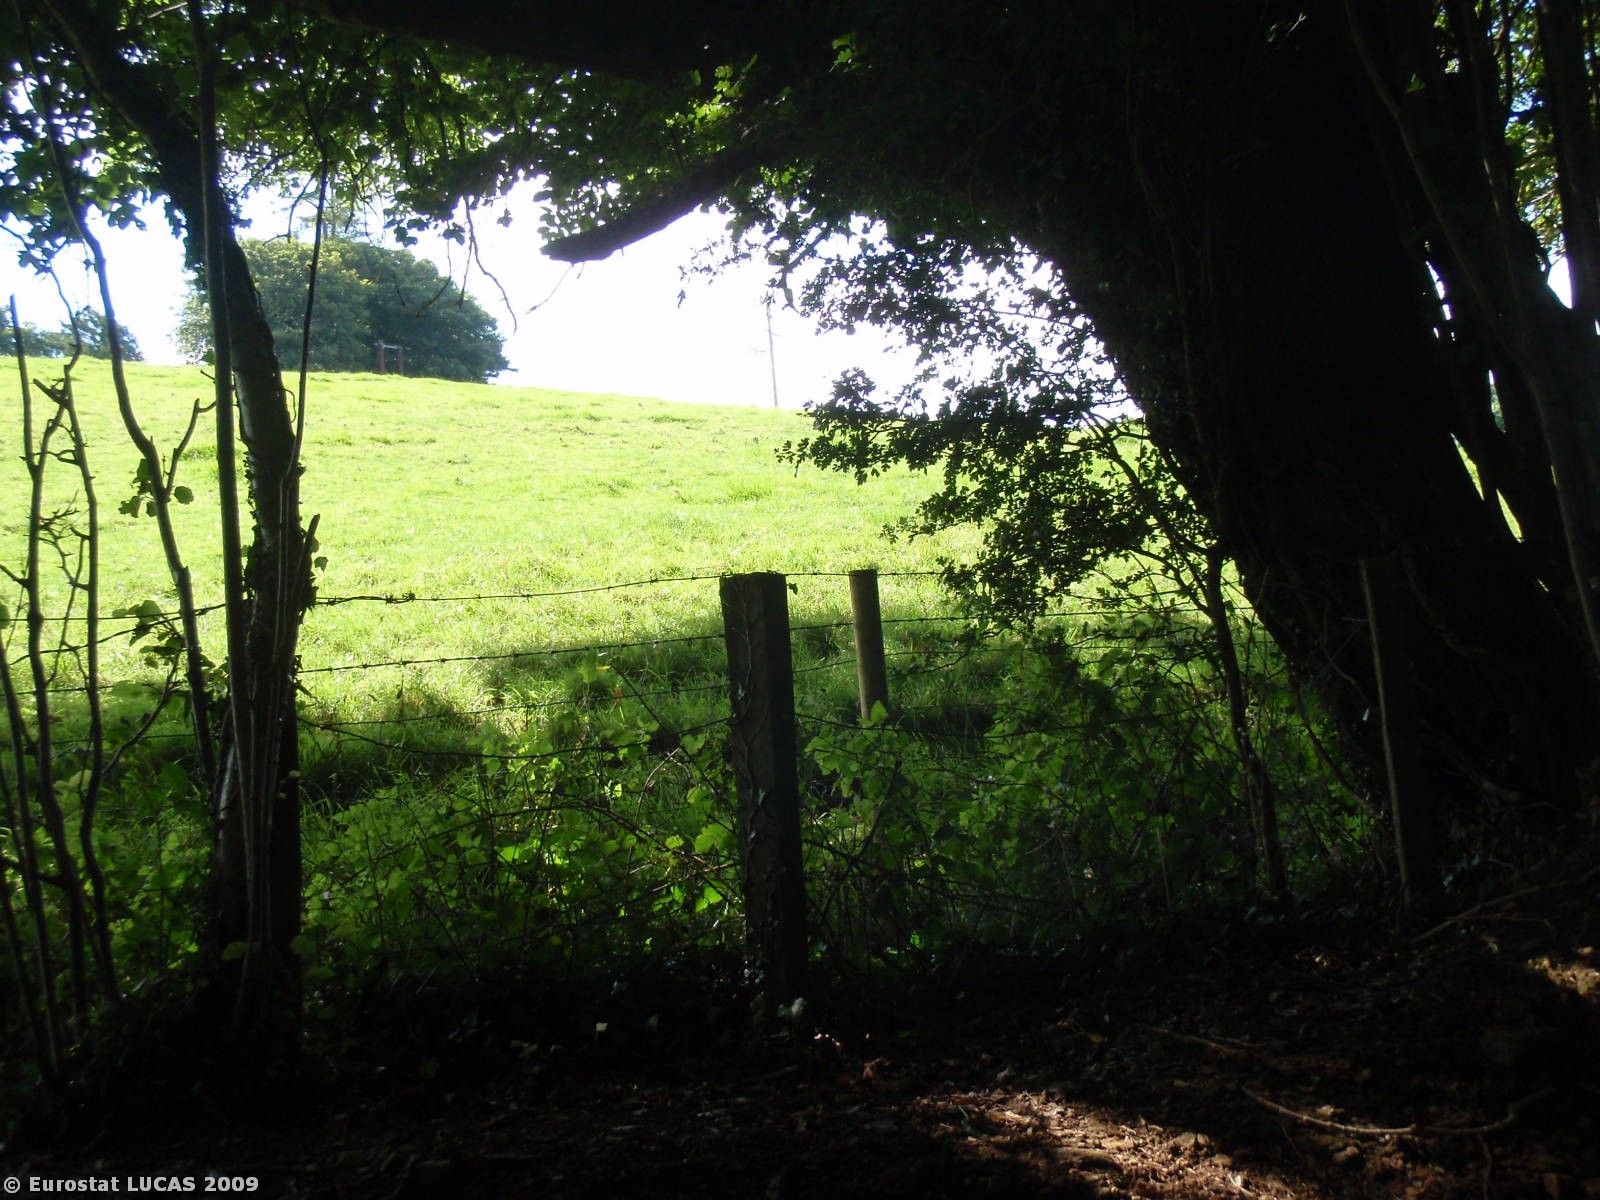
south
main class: Woodland
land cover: Broadleaved woodland
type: mesophytic deciduous forest
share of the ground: > 75 %
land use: Unused
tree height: > 5 m
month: August
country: GB
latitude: 50.6347
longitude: -4.3965
